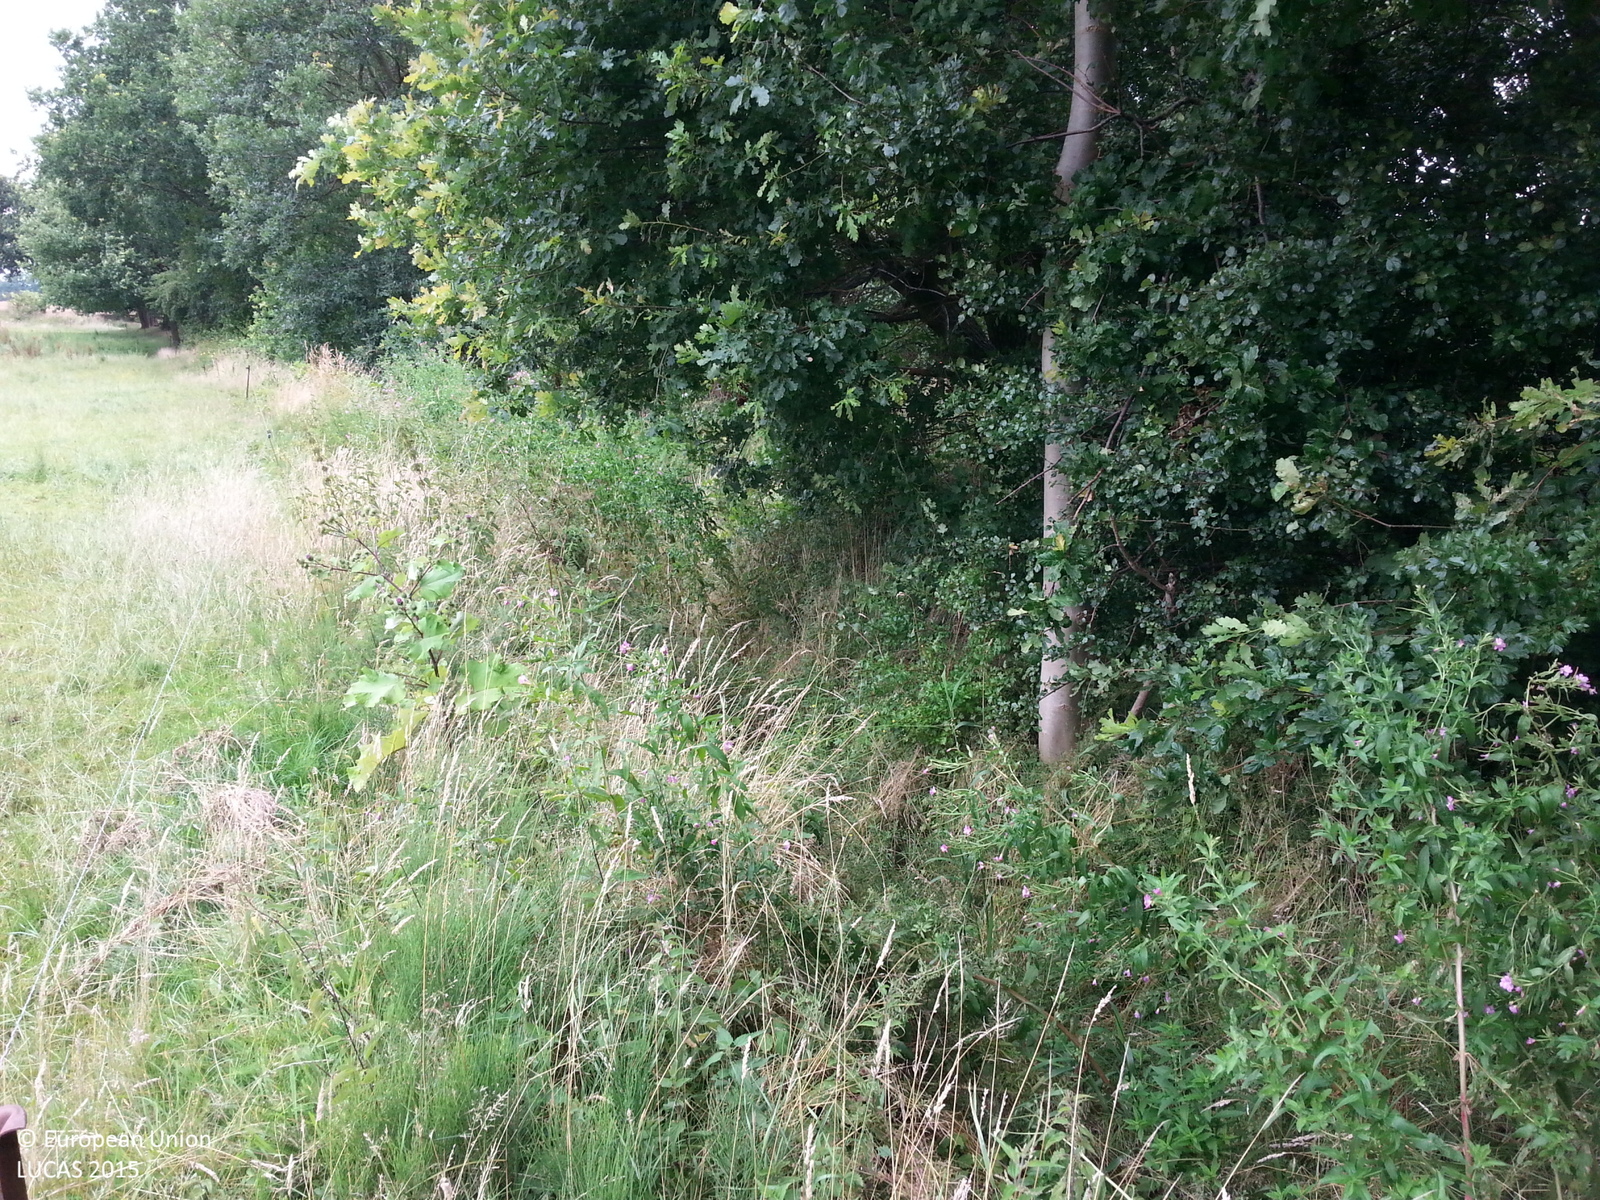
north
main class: Grassland
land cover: Grassland without tree/shrub cover
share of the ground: > 75 %
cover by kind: herbaceous plants 100 %
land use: Agriculture (excluding fallow land and kitchen gardens)
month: July
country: DE
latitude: 53.1994
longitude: 12.3496
